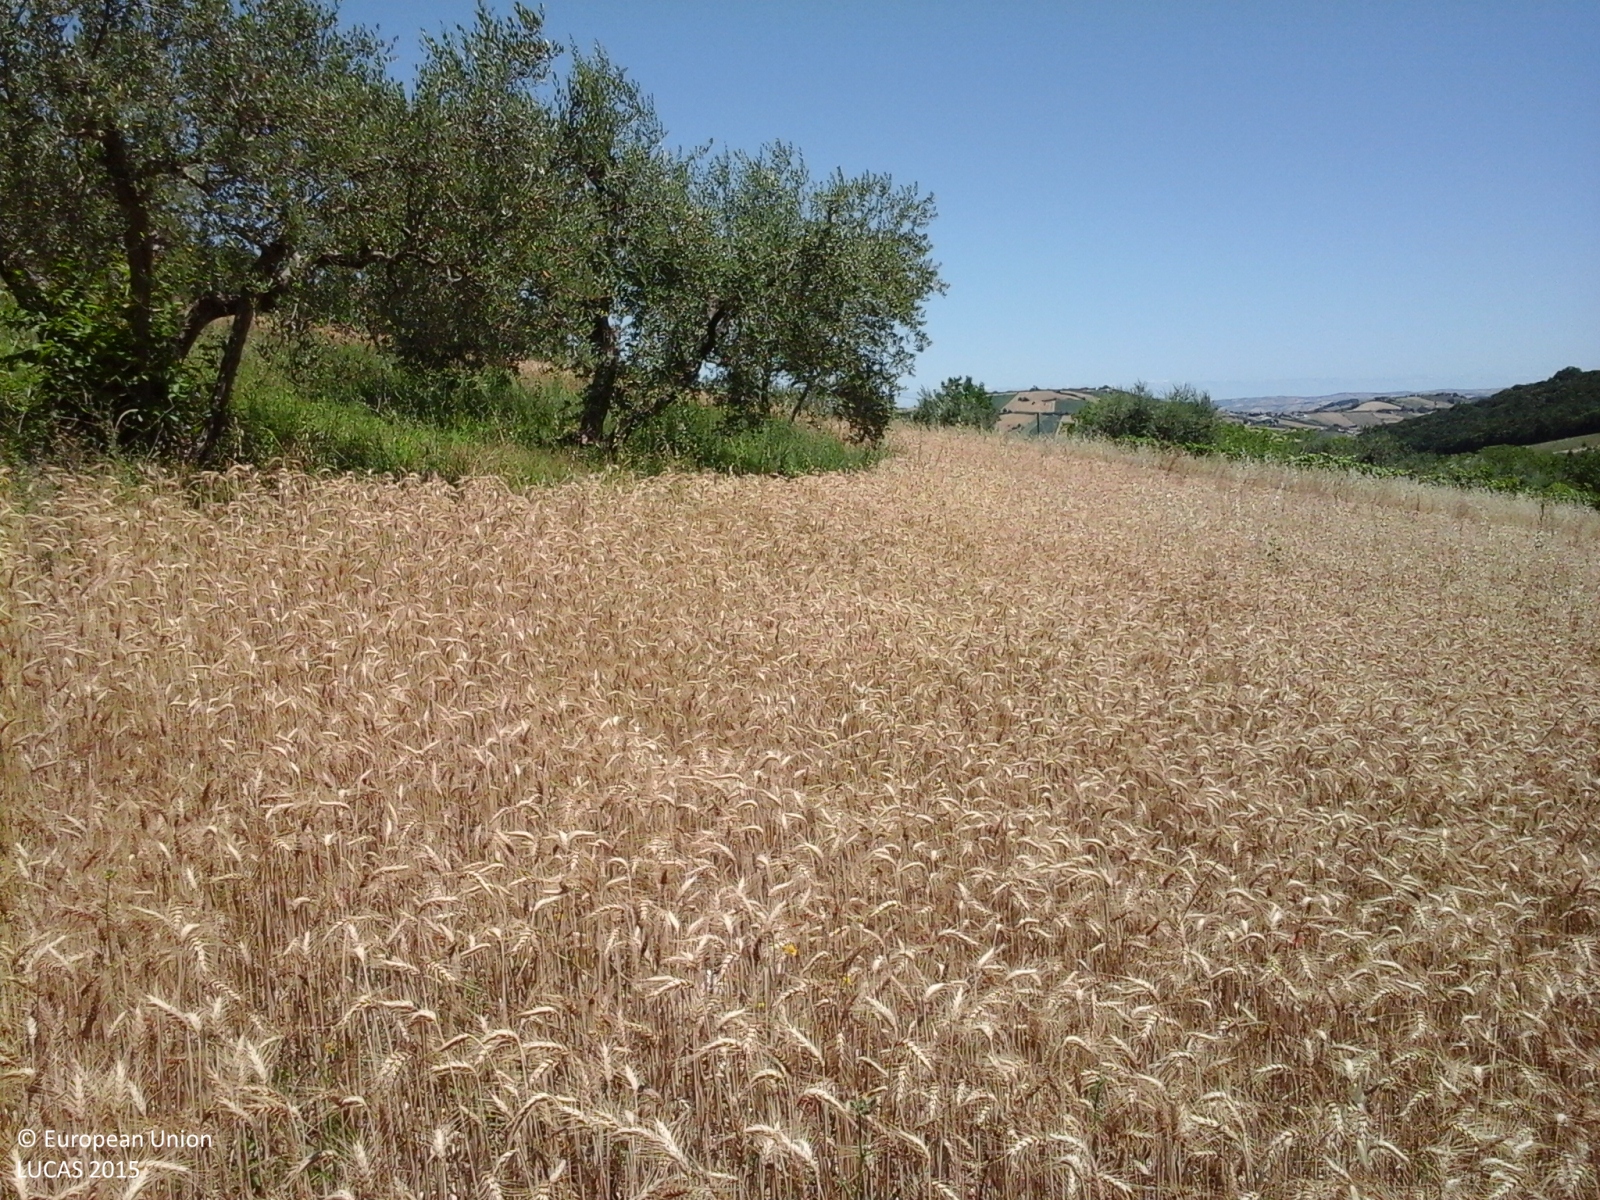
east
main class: Cropland
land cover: Triticale
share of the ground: > 75 %
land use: Agriculture (excluding fallow land and kitchen gardens)
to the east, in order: Triticale; Olive groves; Triticale; Tracks; Olive groves; Tracks; Electric lines; Olive groves; Spontaneously vegetated surfaces; Vineyards
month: June
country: IT
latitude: 42.1495
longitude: 14.2341
